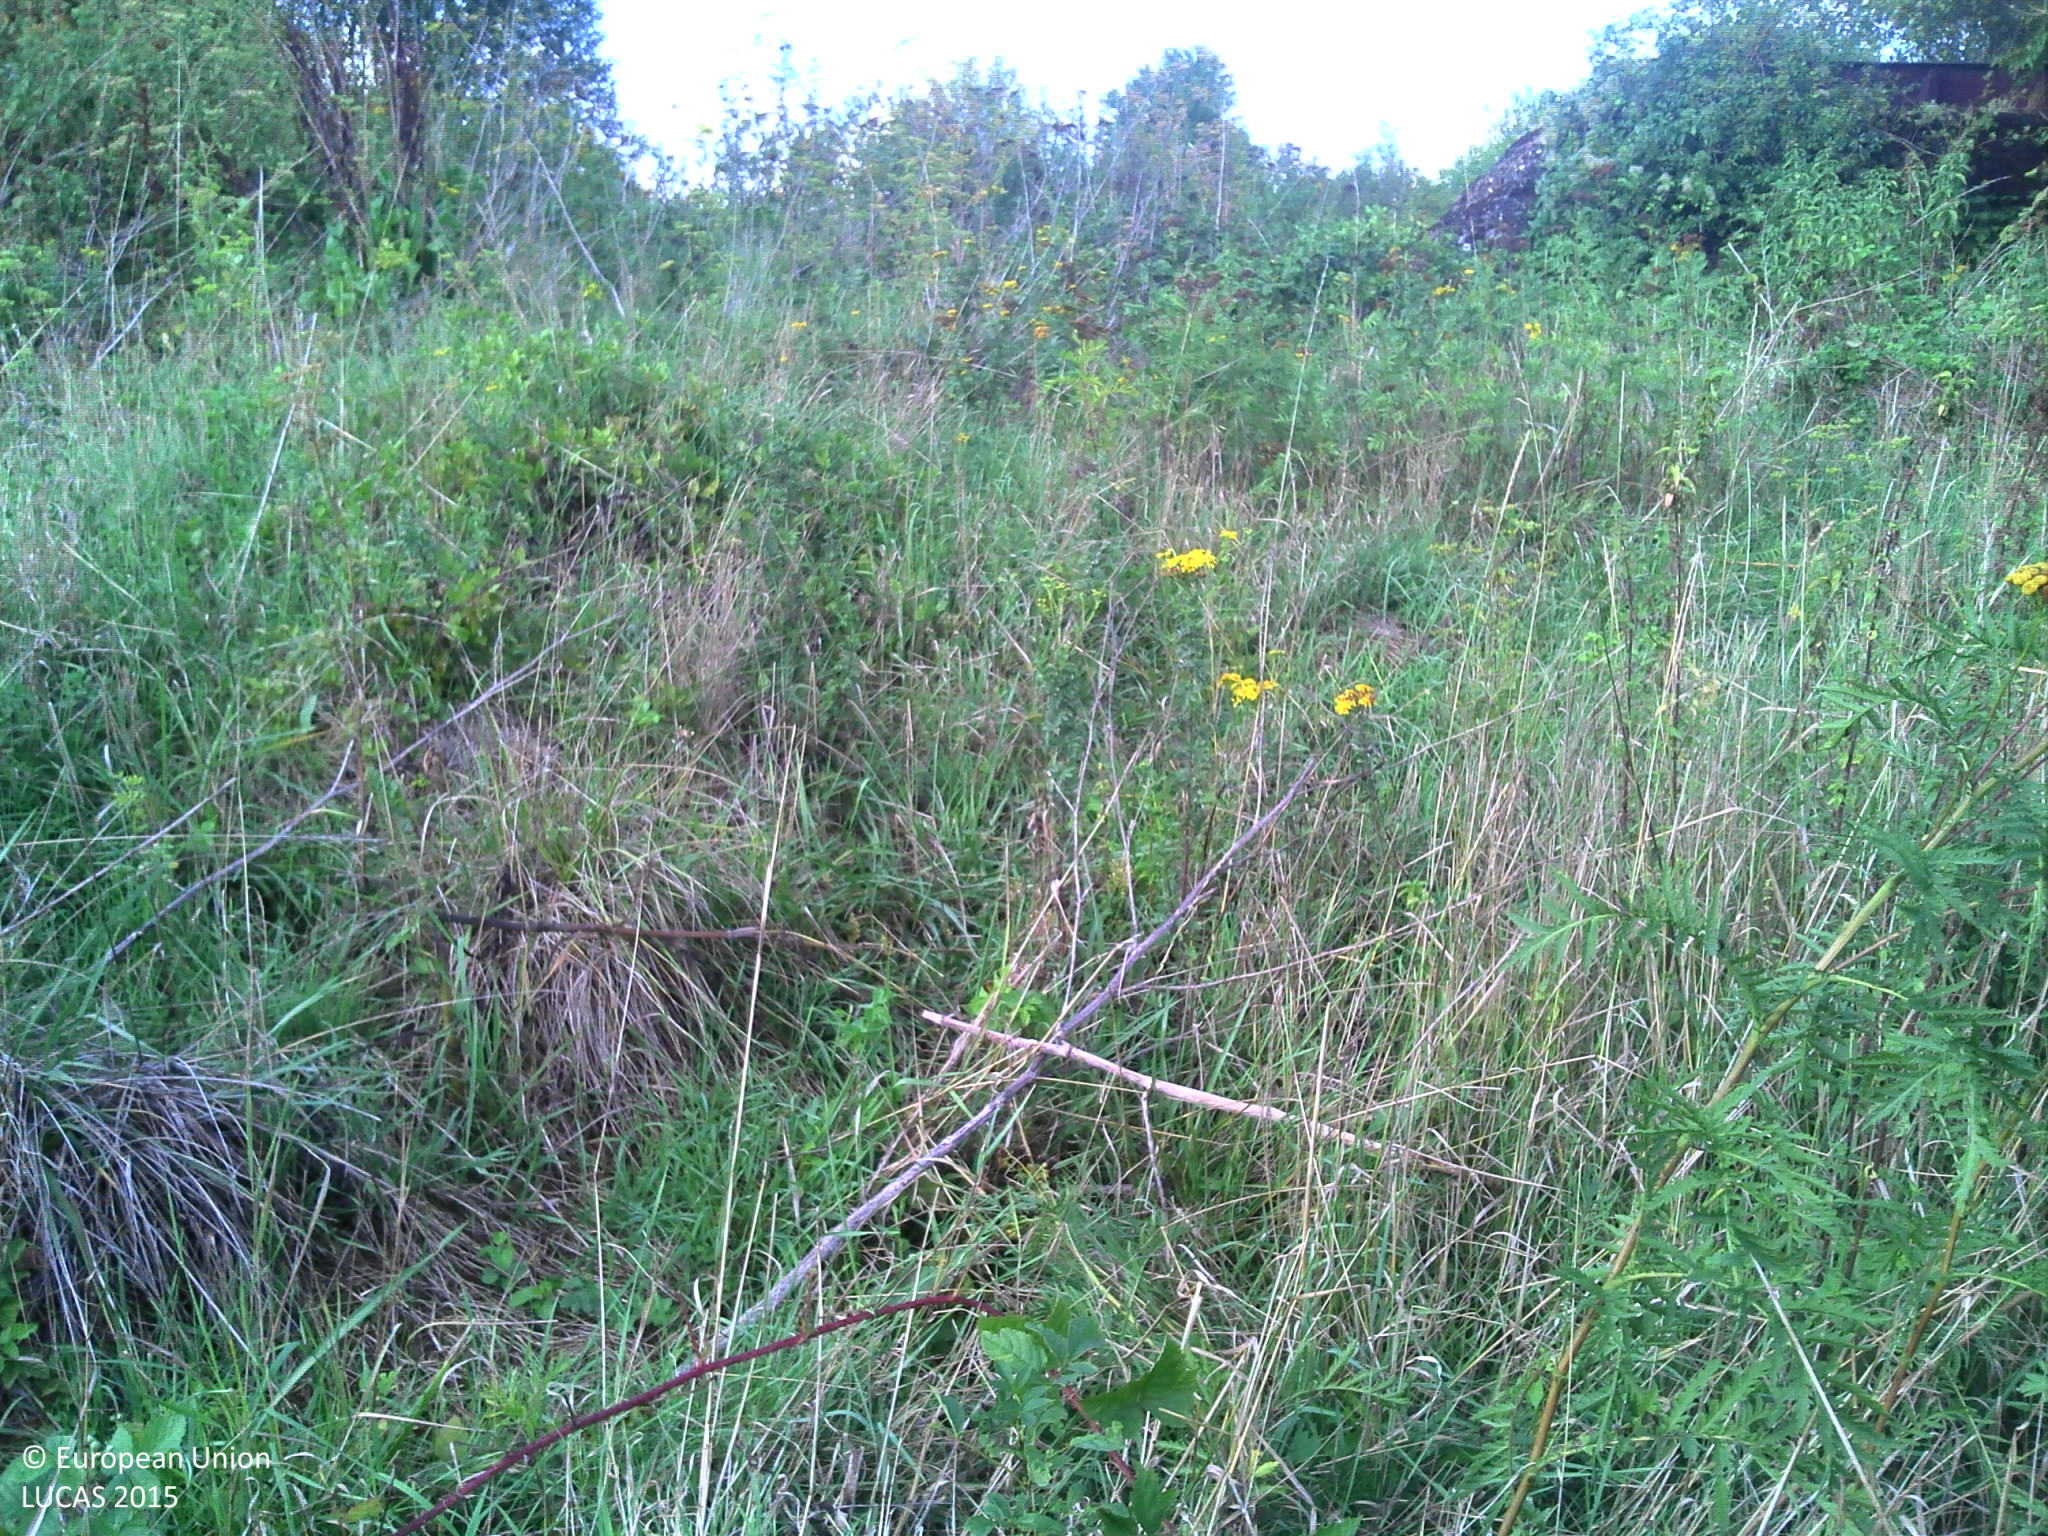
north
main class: Shrubland
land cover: Shrubland with sparse tree cover
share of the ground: > 75 %
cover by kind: shrubs 50 %, herbaceous plants 30 %, consolidated bare surface 15 %, broadleaved forest trees 5 %
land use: Semi-natural and natural areas not in use
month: September
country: FR
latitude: 49.2120
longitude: 5.9498
